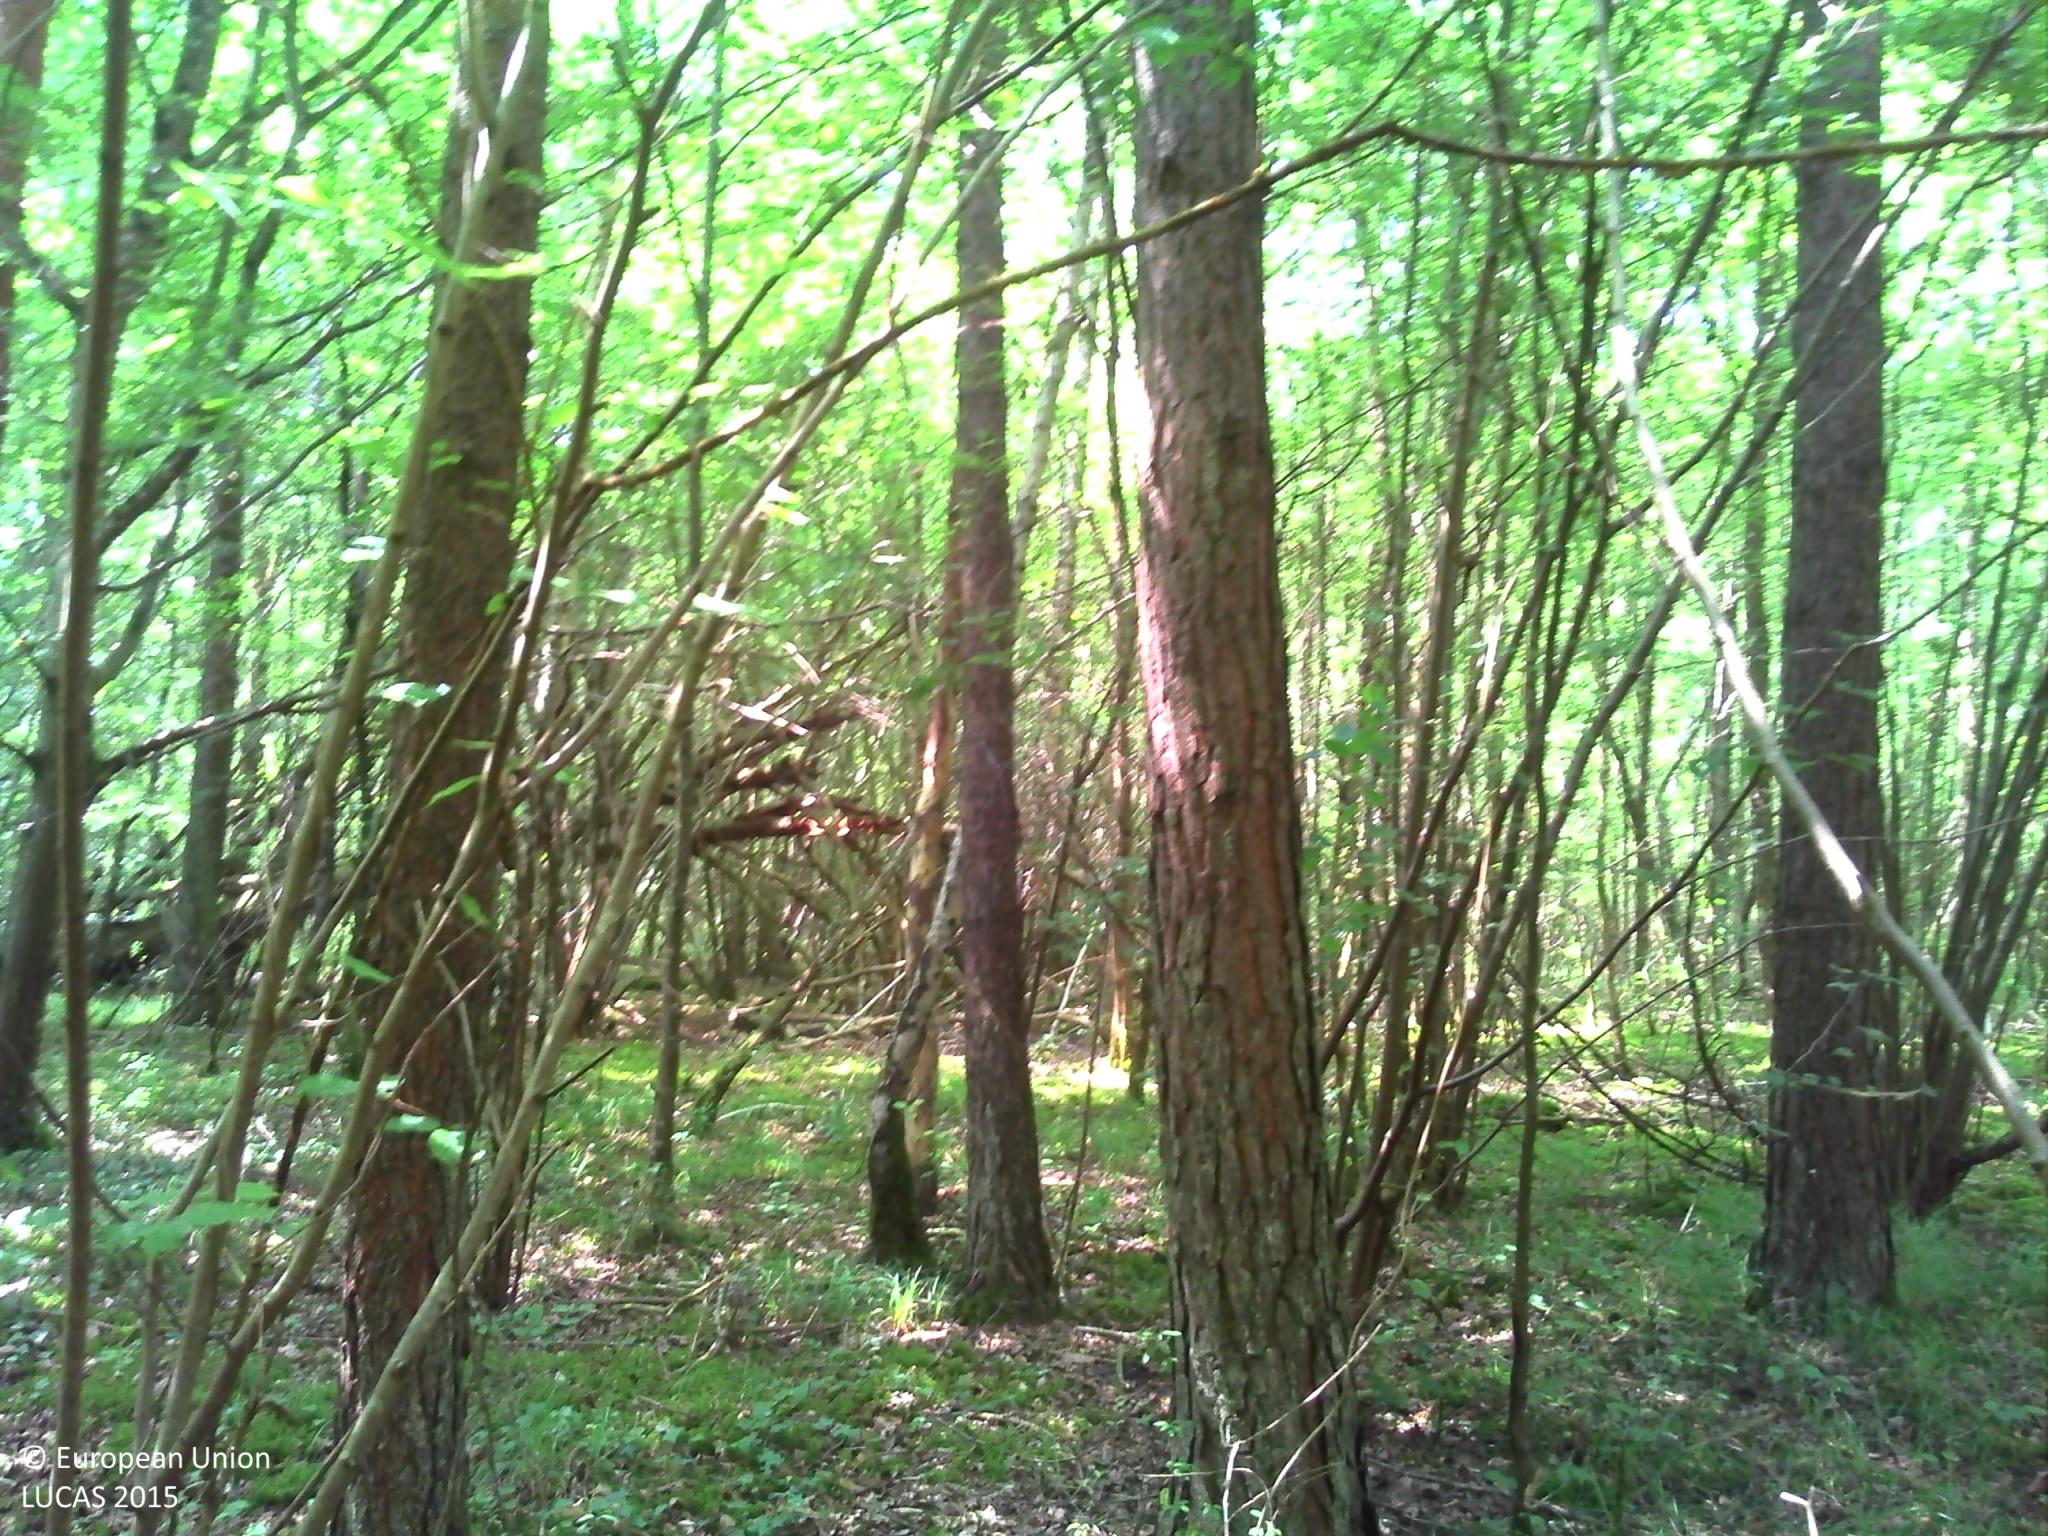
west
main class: Woodland
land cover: Pine dominated mixed woodland
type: hemiboreal forest and nemoral coniferous forest and mixed broadleaved-coniferous forest
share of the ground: > 75 %
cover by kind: coniferous forest trees 50 %, broadleaved forest trees 25 %, herbaceous plants 25 %
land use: Forestry
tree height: > 5 m
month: July
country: FR
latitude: 47.7551
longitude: 2.8294
